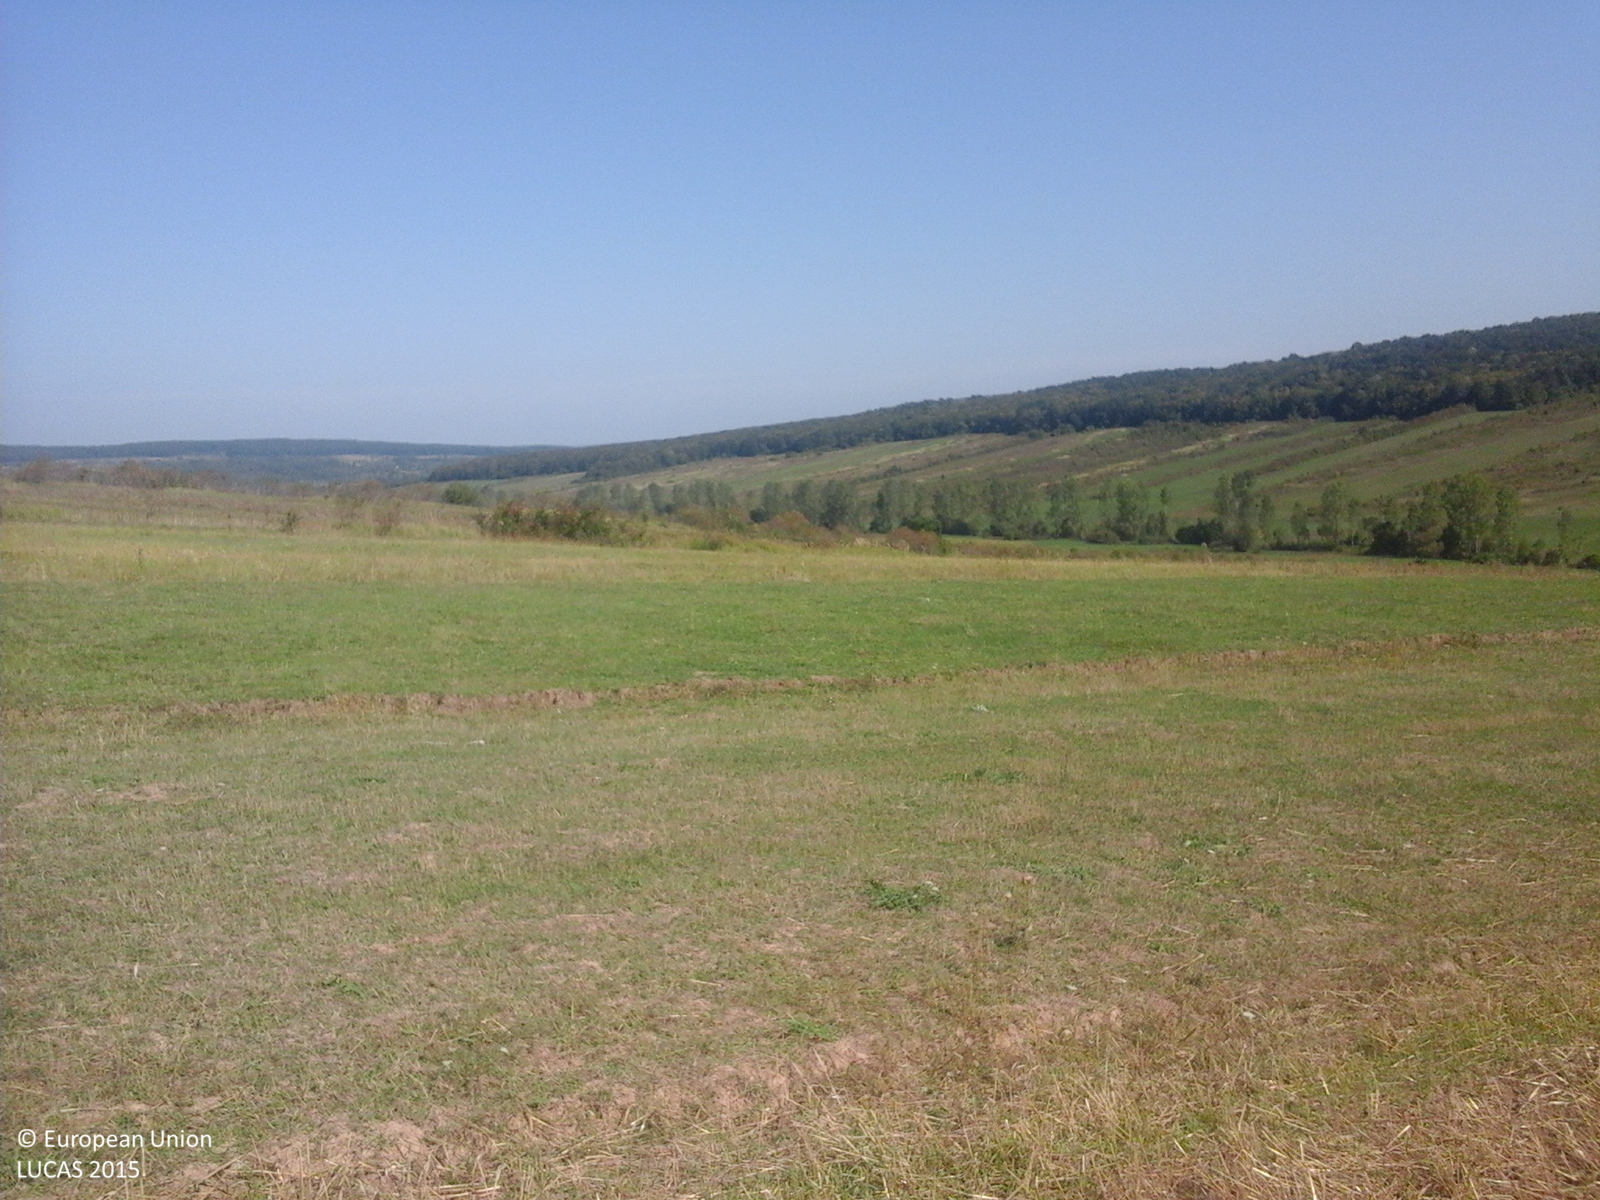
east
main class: Cropland
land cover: Common wheat
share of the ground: < 10 %
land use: Agriculture (excluding fallow land and kitchen gardens)
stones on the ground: < 10 %
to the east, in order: Common wheat; Grassland without tree/shrub cover; Spontaneously vegetated surfaces; Grassland without tree/shrub cover; Ditches and canals; Grass margins; Tracks; Grass margins; Grassland without tree/shrub cover; Common wheat
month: September
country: RO
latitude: 47.1621
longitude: 22.8158
